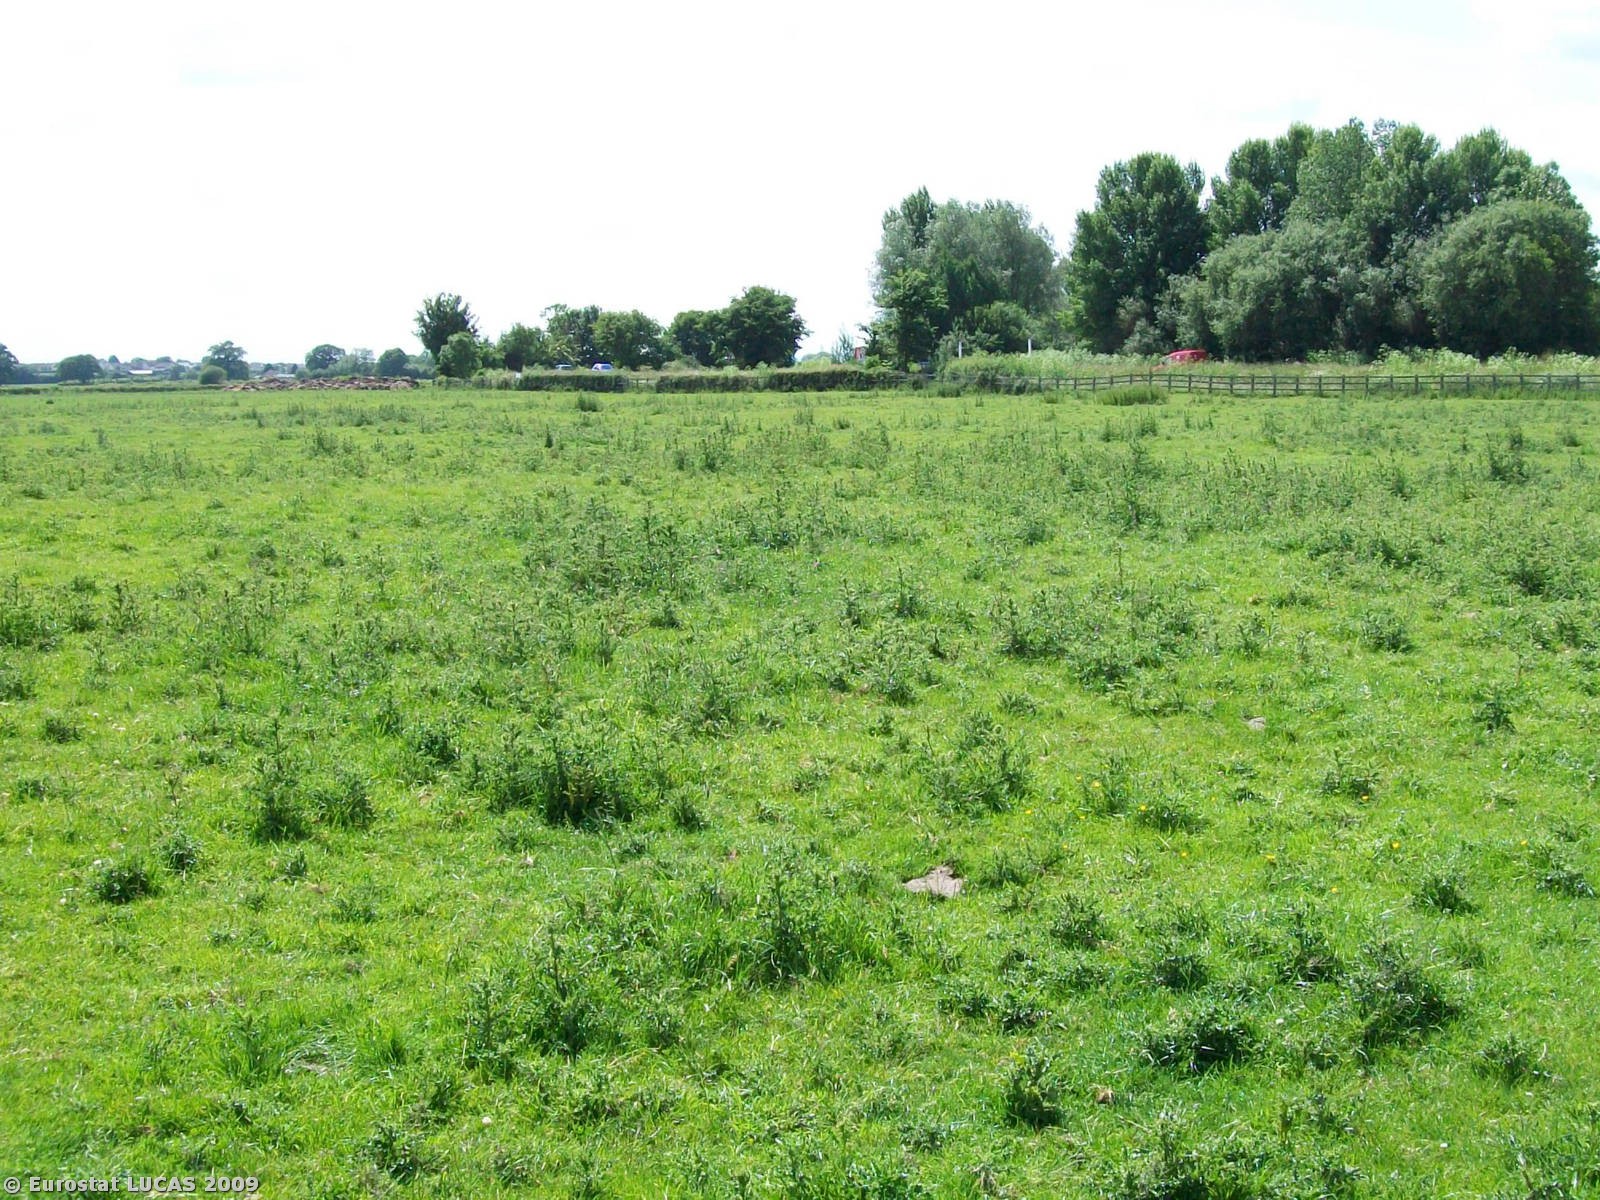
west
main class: Grassland
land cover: Grassland without tree/shrub cover
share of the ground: > 75 %
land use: Agriculture (excluding fallow land and kitchen gardens)
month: June
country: GB
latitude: 51.0228
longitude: -2.6576
